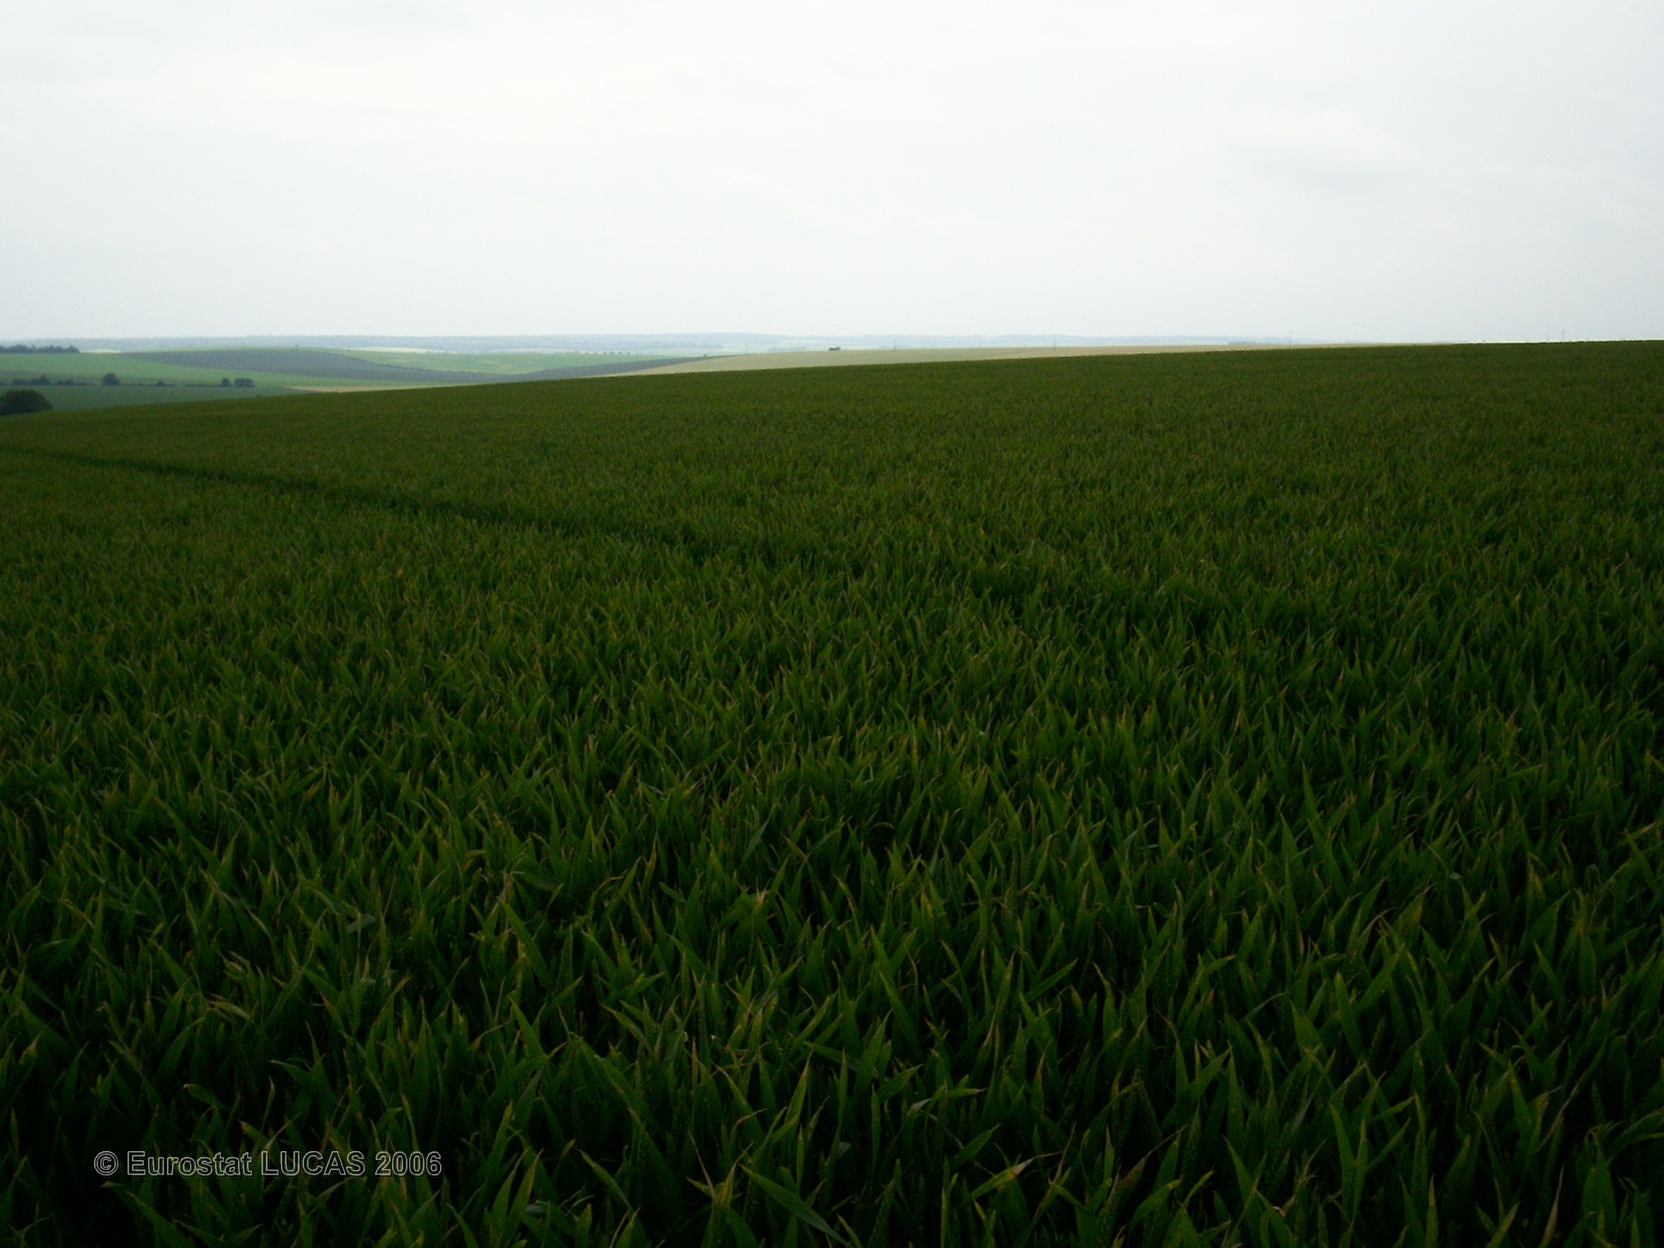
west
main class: Cropland
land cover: Common wheat
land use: Agriculture (excluding fallow land and kitchen gardens)
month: June
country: FR
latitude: 48.6619
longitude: 4.4711
